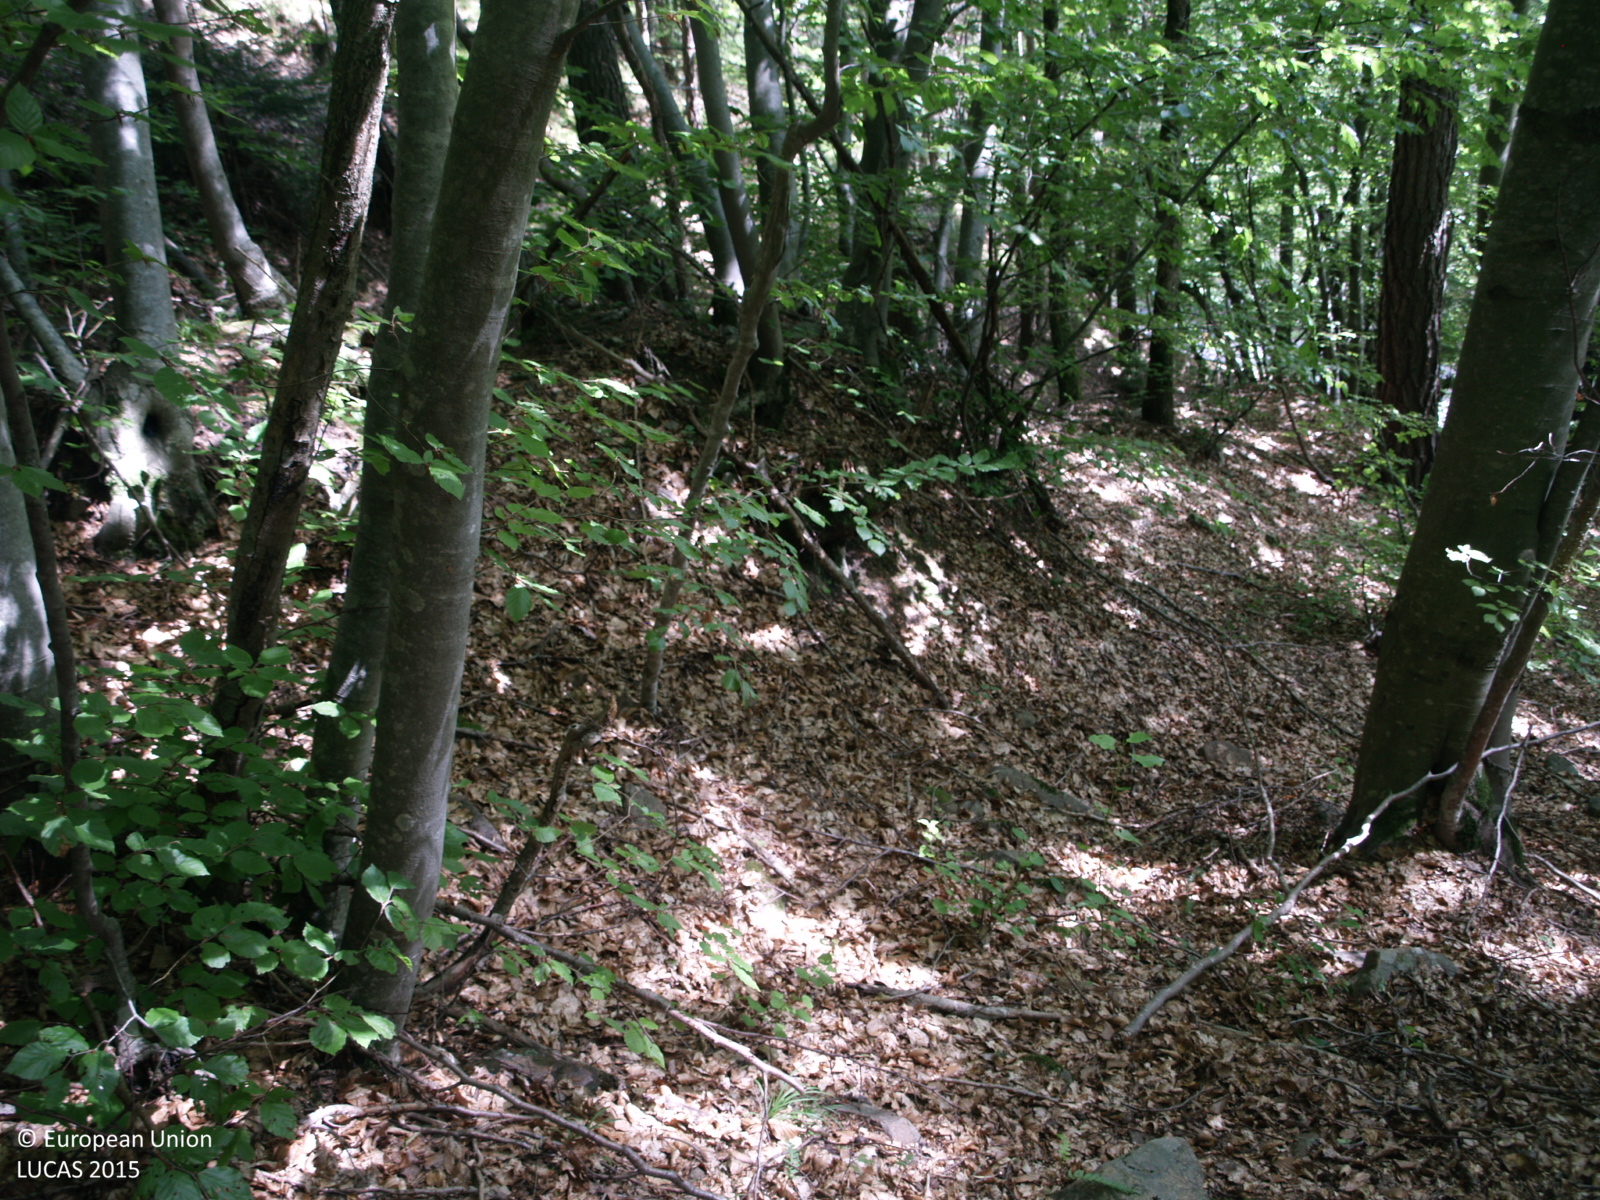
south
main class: Woodland
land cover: Broadleaved woodland
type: mountainous beech forest
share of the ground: > 75 %
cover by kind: broadleaved forest trees 100 %
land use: Forestry
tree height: > 5 m
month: May
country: IT
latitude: 45.8411
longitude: 11.0928
